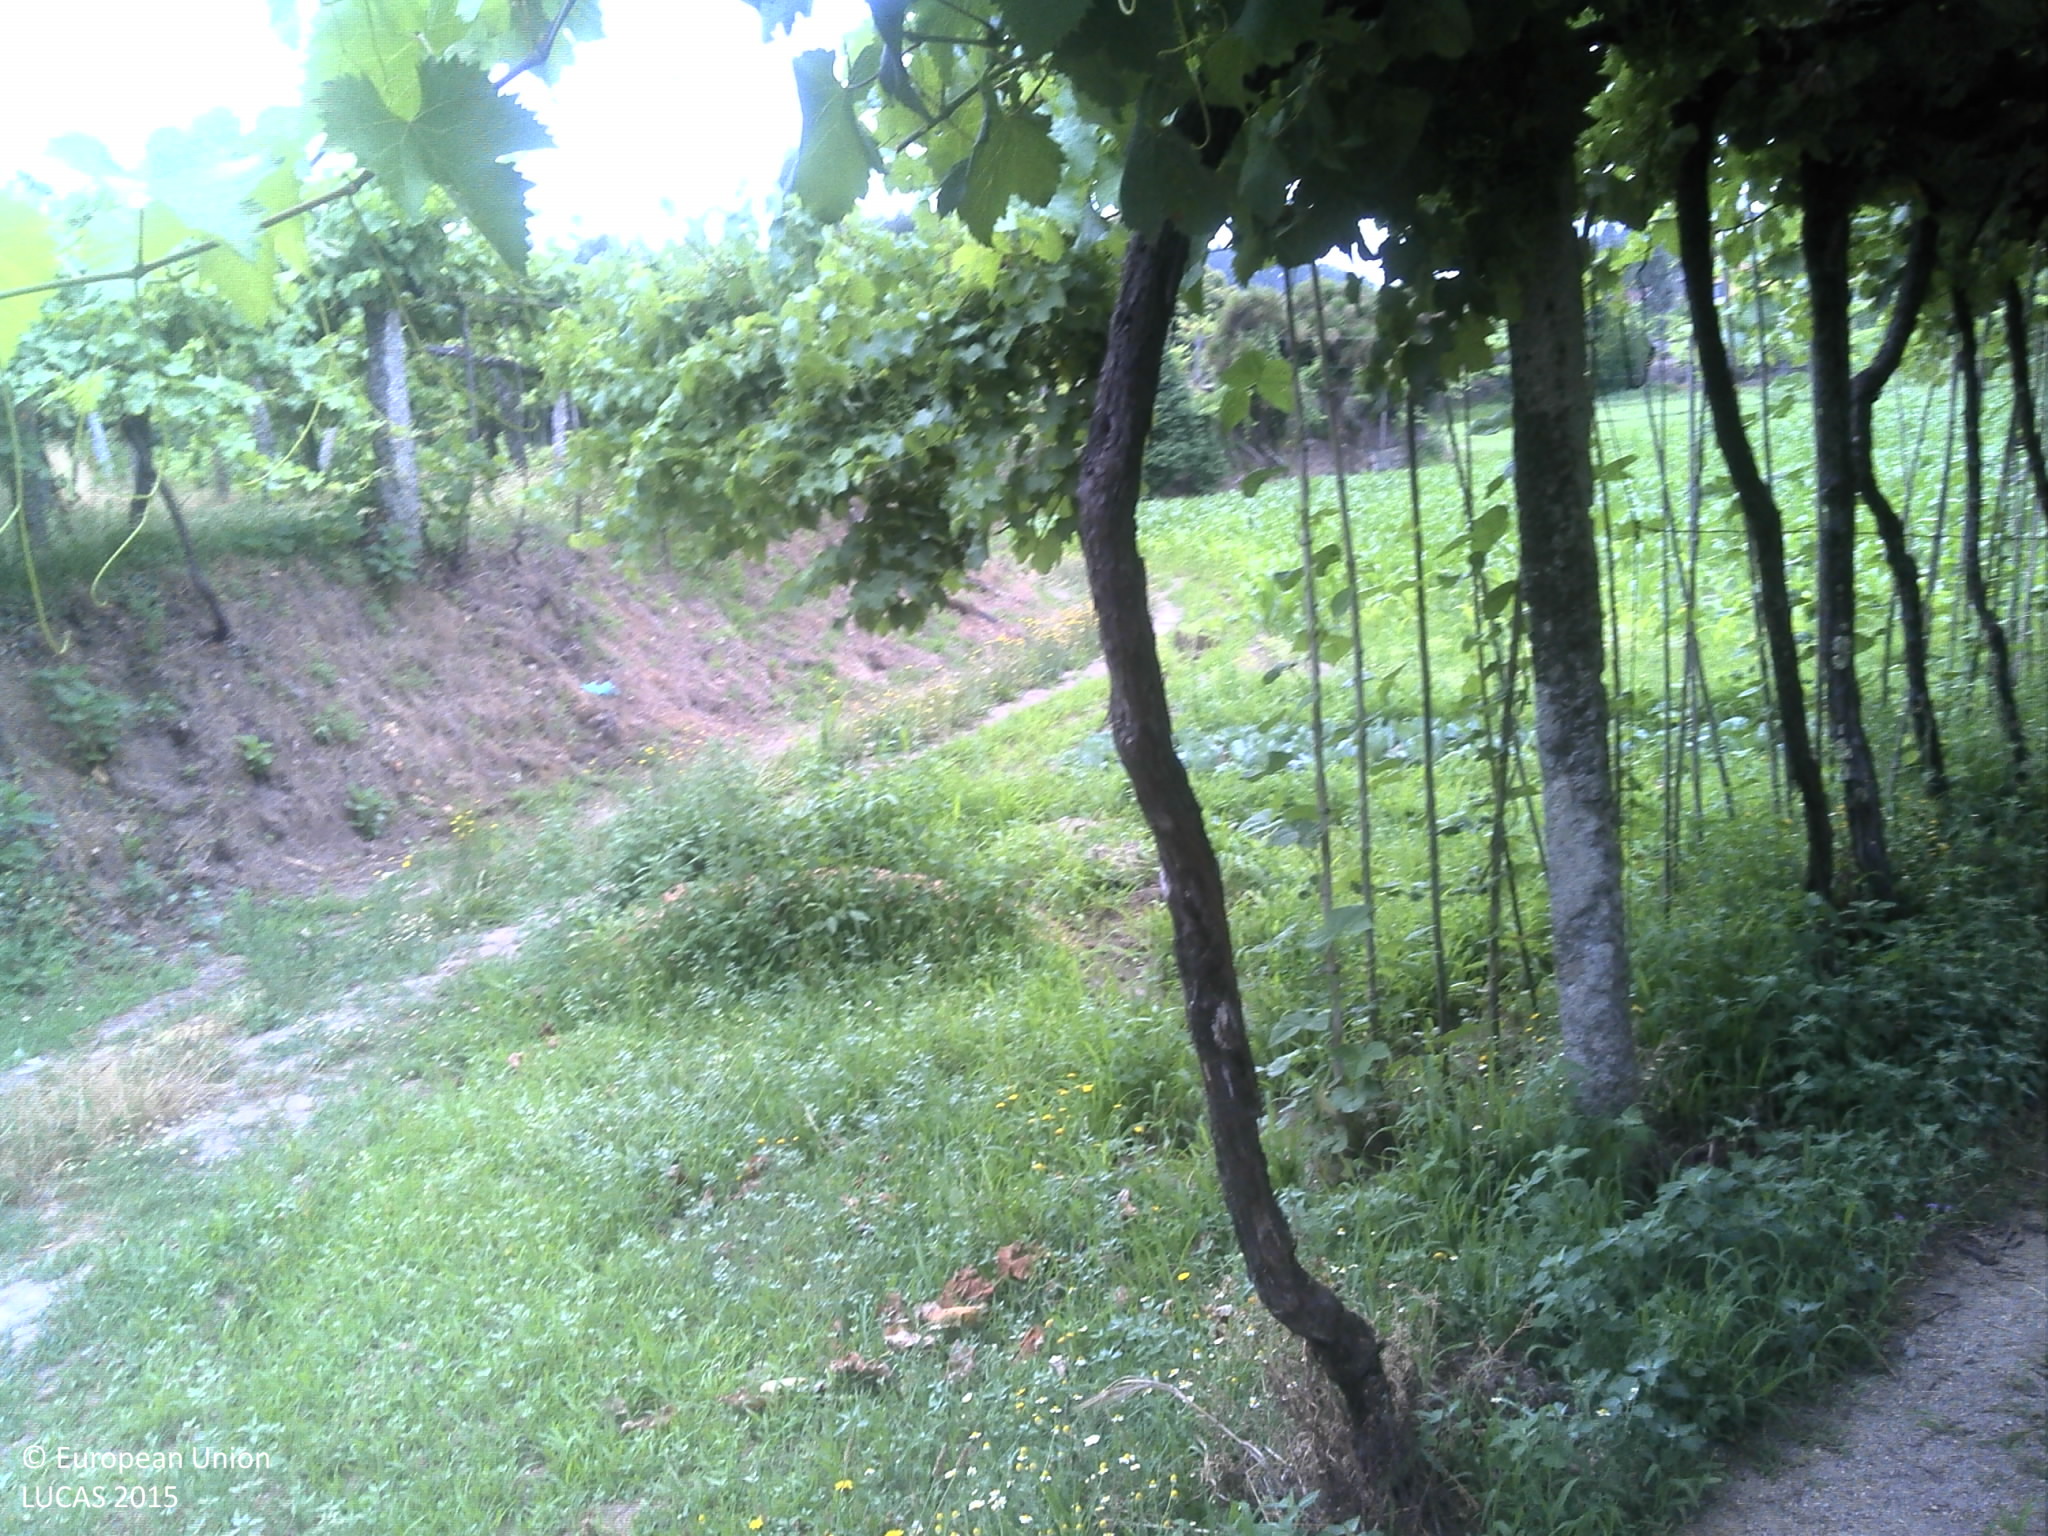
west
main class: Cropland
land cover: Vineyards
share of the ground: > 75 %
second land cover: Grassland without tree/shrub cover
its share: 10 - 25 %
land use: Agriculture (excluding fallow land and kitchen gardens)
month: June
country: PT
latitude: 41.2258
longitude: -8.2152
